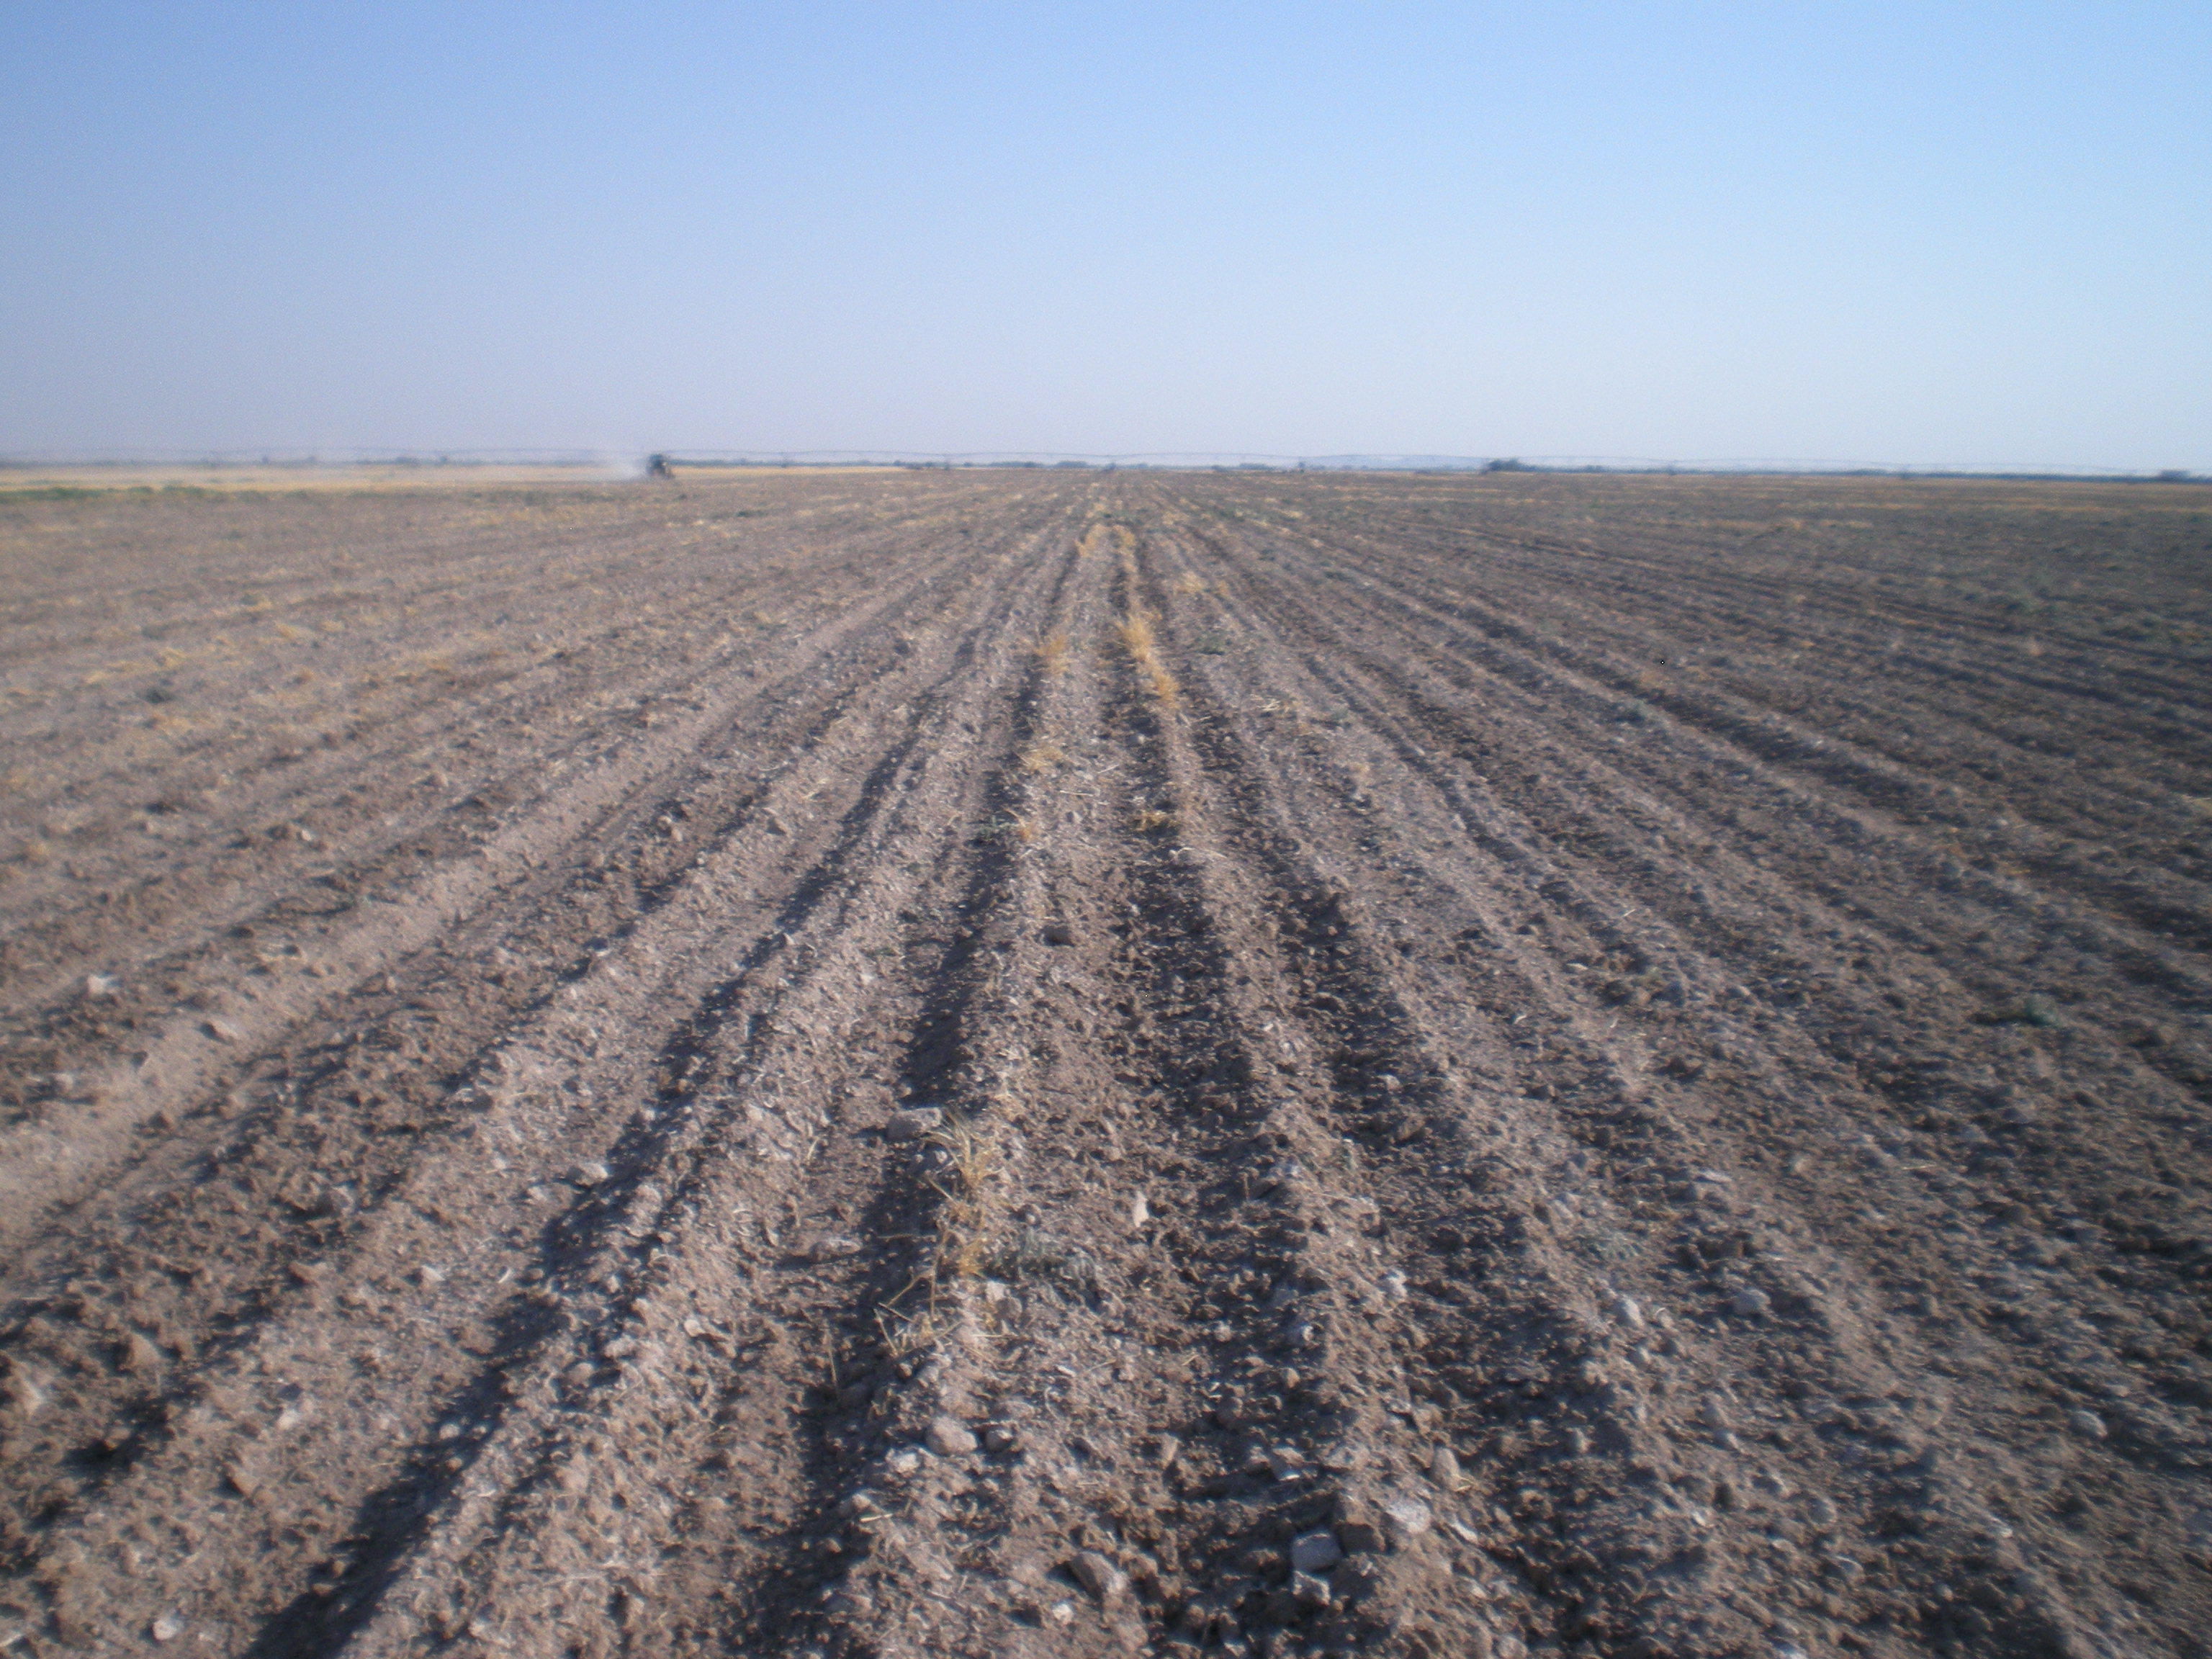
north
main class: Cropland
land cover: Barley
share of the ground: < 10 %
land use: Agriculture (excluding fallow land and kitchen gardens)
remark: Harvested field
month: June
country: ES
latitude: 39.5472
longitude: -3.2515
